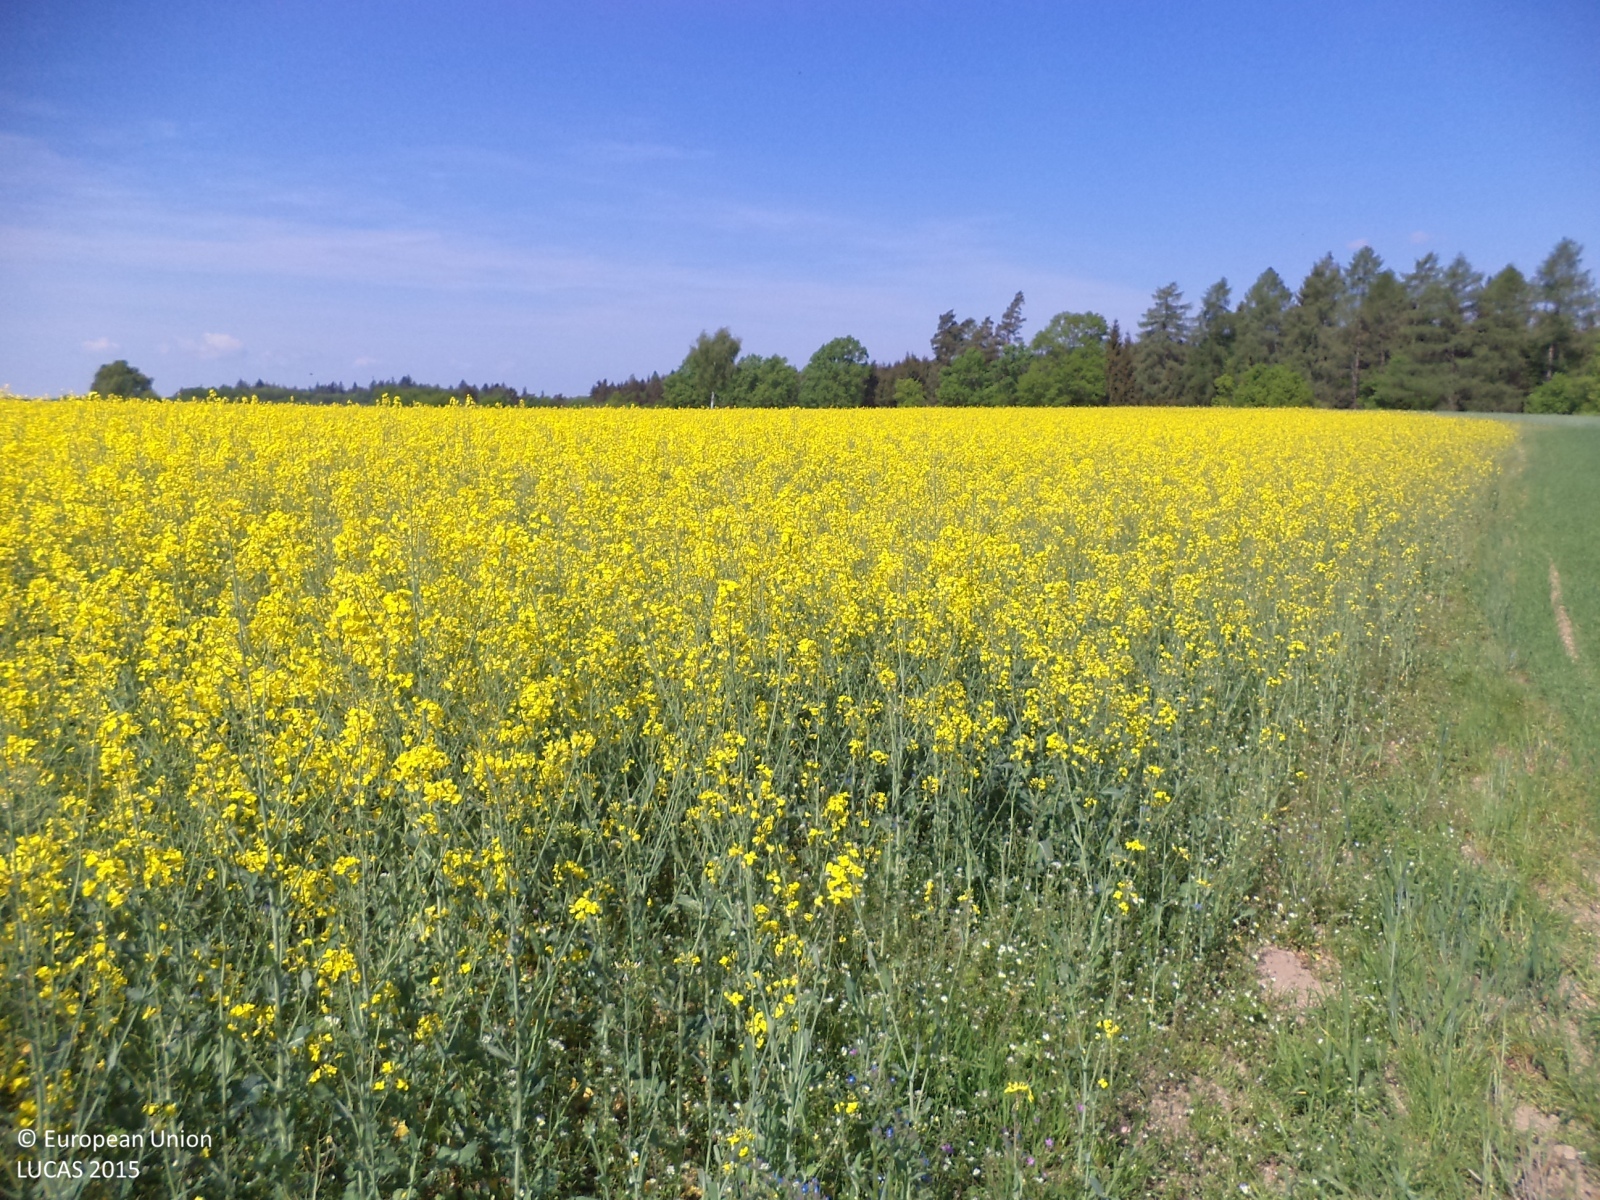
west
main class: Cropland
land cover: Rape and turnip rape
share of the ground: > 75 %
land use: Agriculture (excluding fallow land and kitchen gardens)
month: May
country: CZ
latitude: 49.2499
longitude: 14.9065
